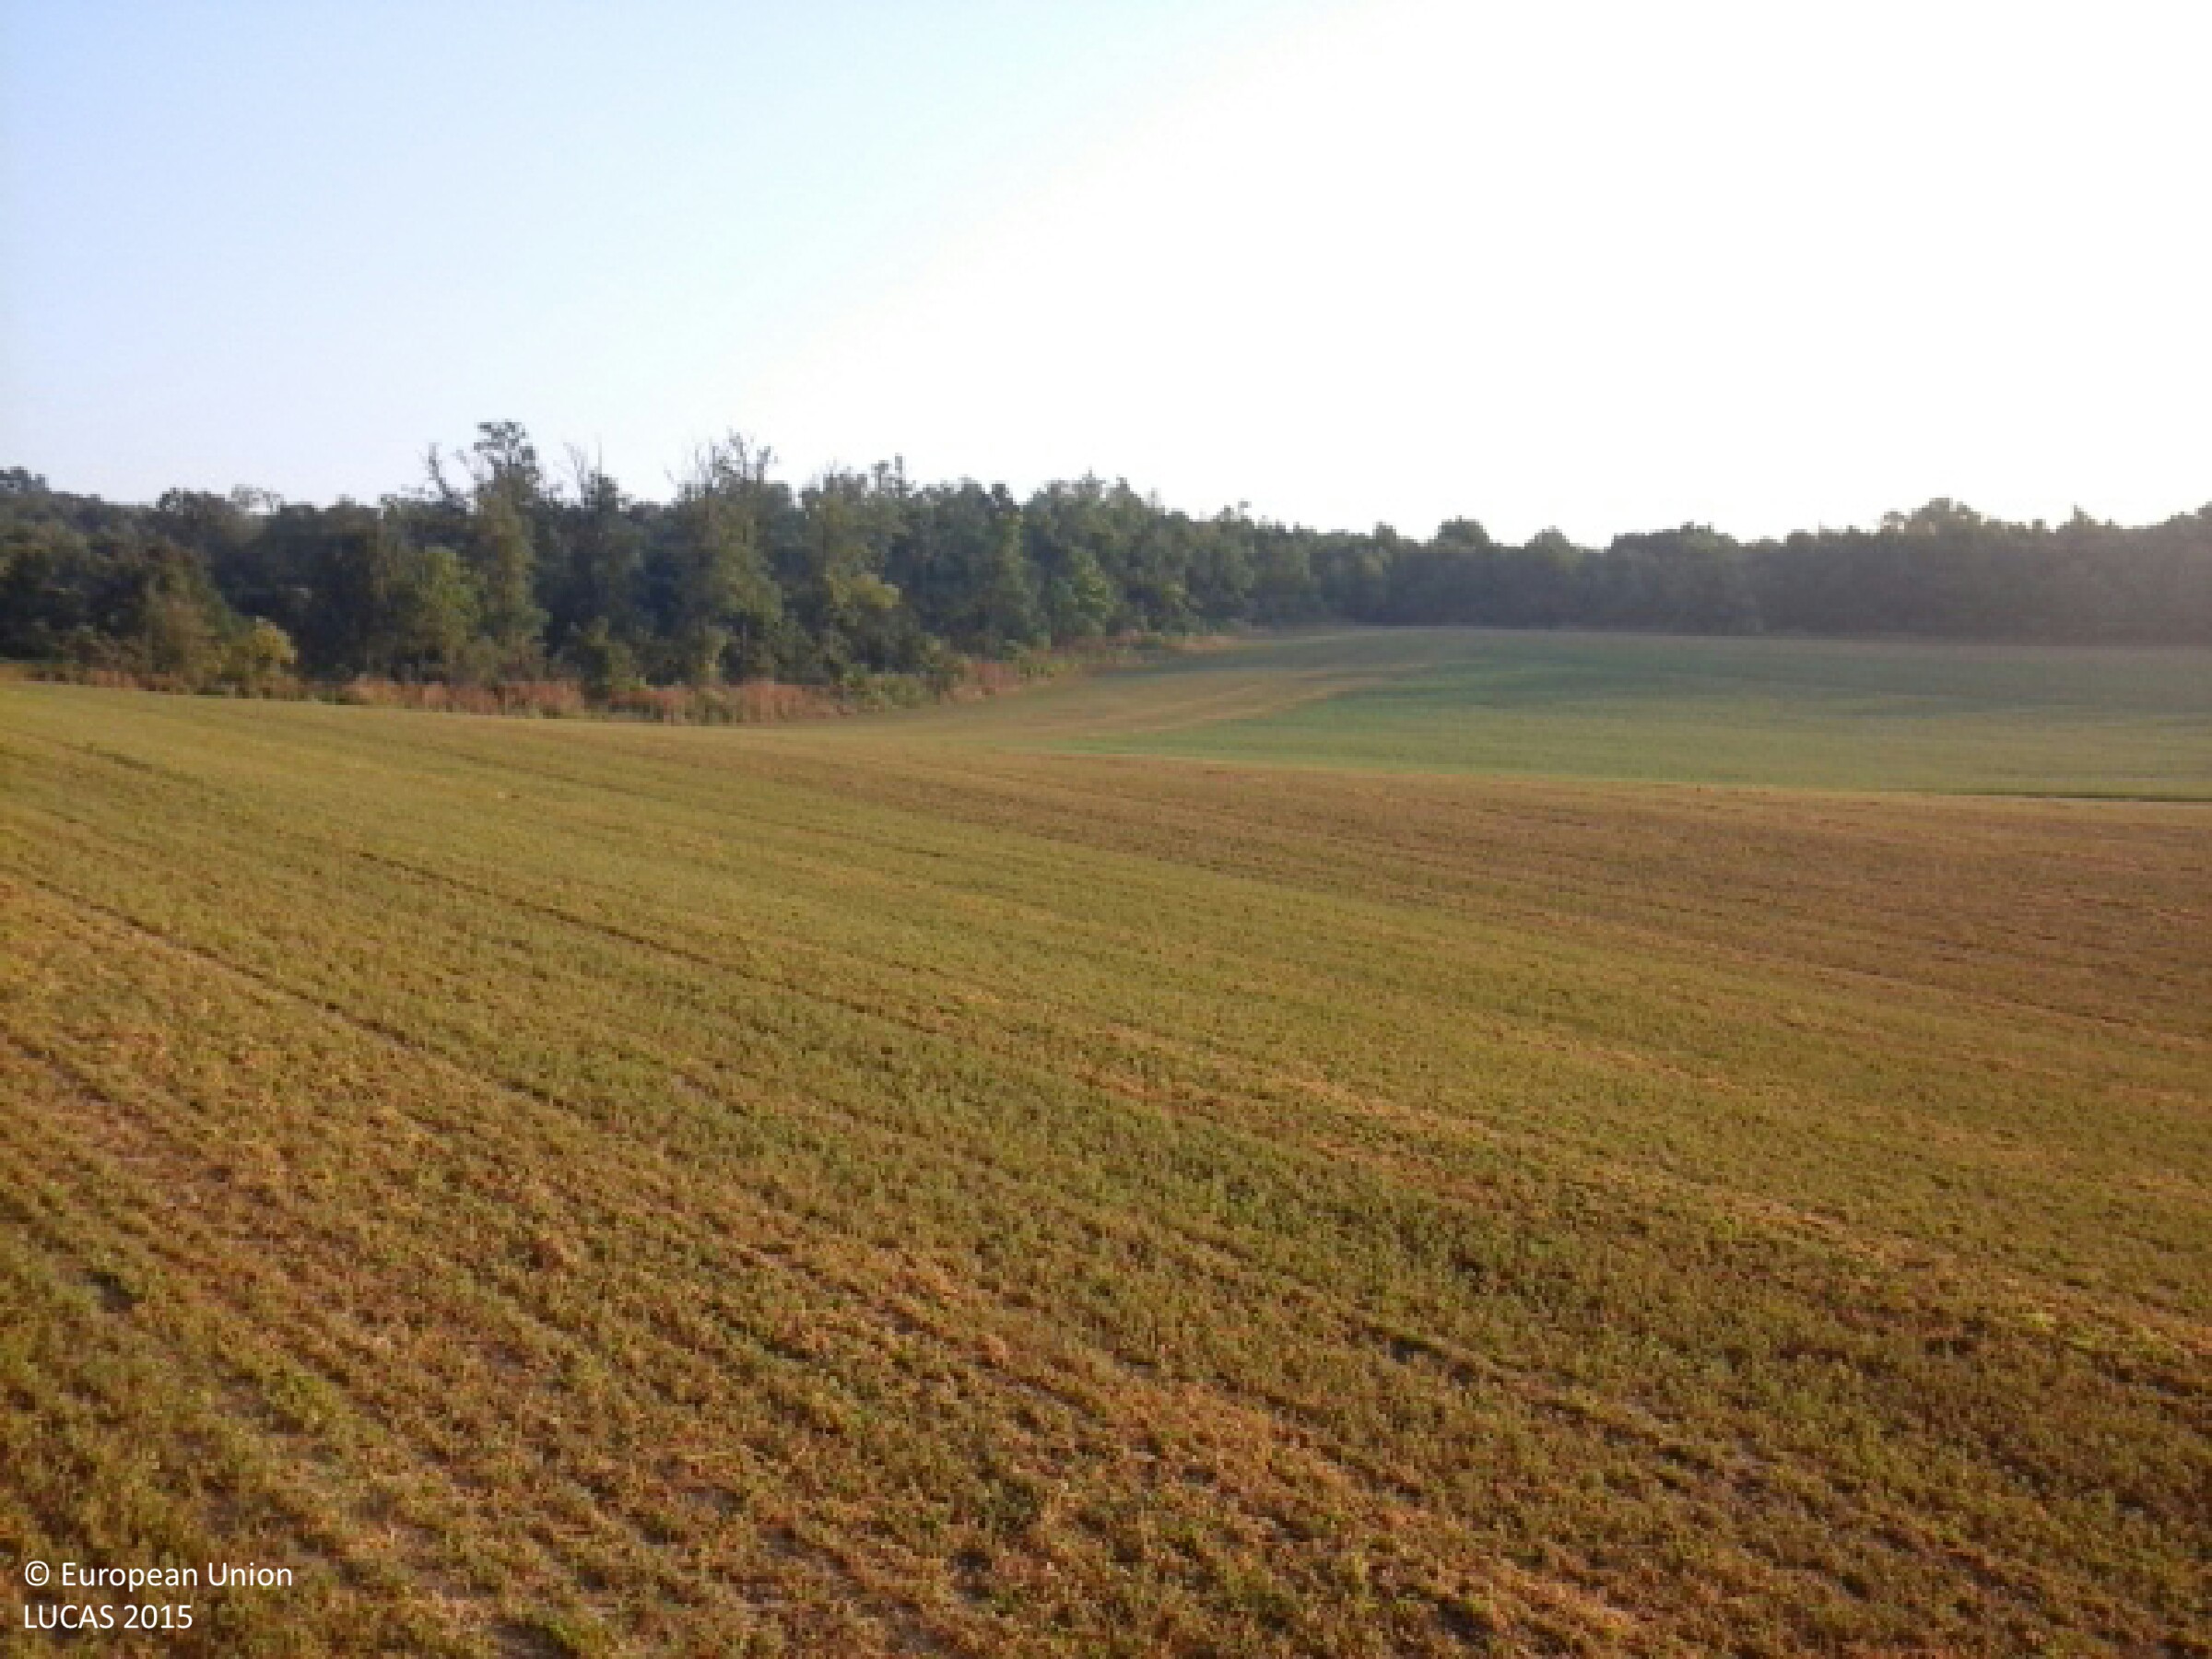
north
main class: Cropland
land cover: Lucerne
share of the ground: 50 - 75 %
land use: Agriculture (excluding fallow land and kitchen gardens)
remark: Harvested field
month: August
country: HU
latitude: 47.5465
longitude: 18.5579
